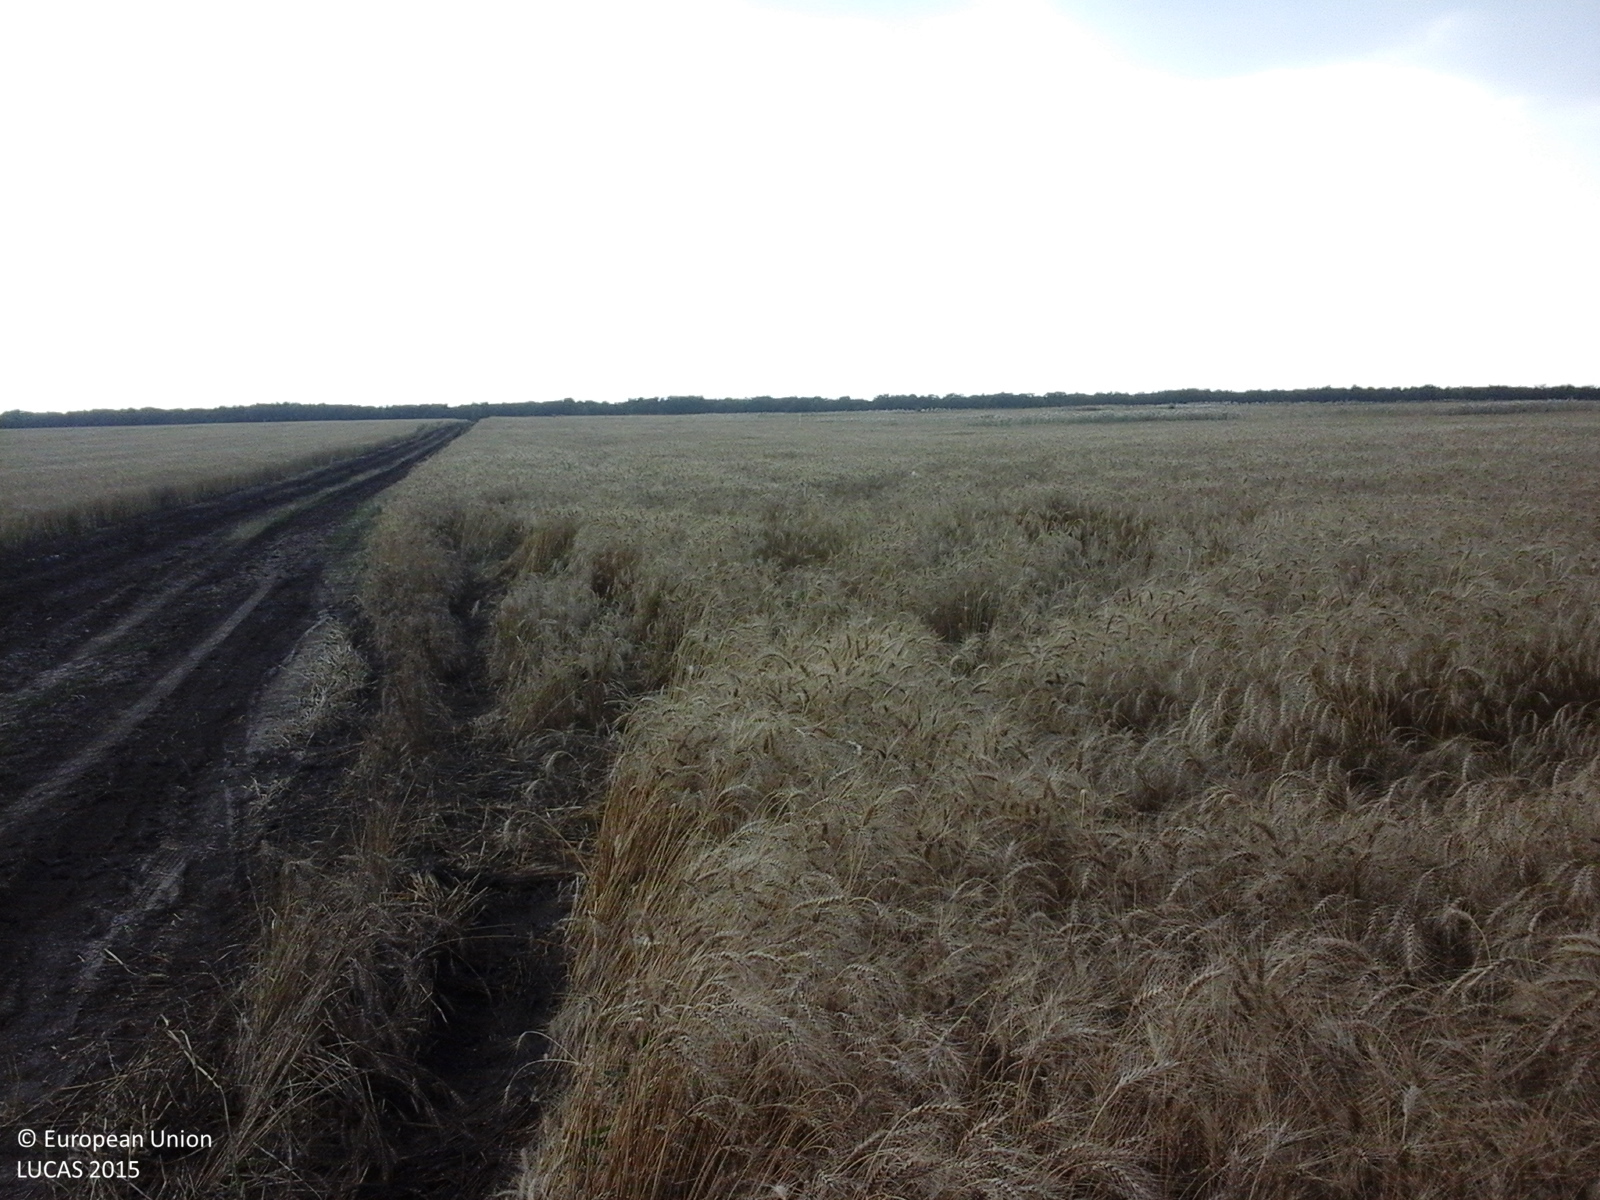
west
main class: Cropland
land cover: Common wheat
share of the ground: > 75 %
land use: Agriculture (excluding fallow land and kitchen gardens)
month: July
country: RO
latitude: 43.7652
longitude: 25.3731
